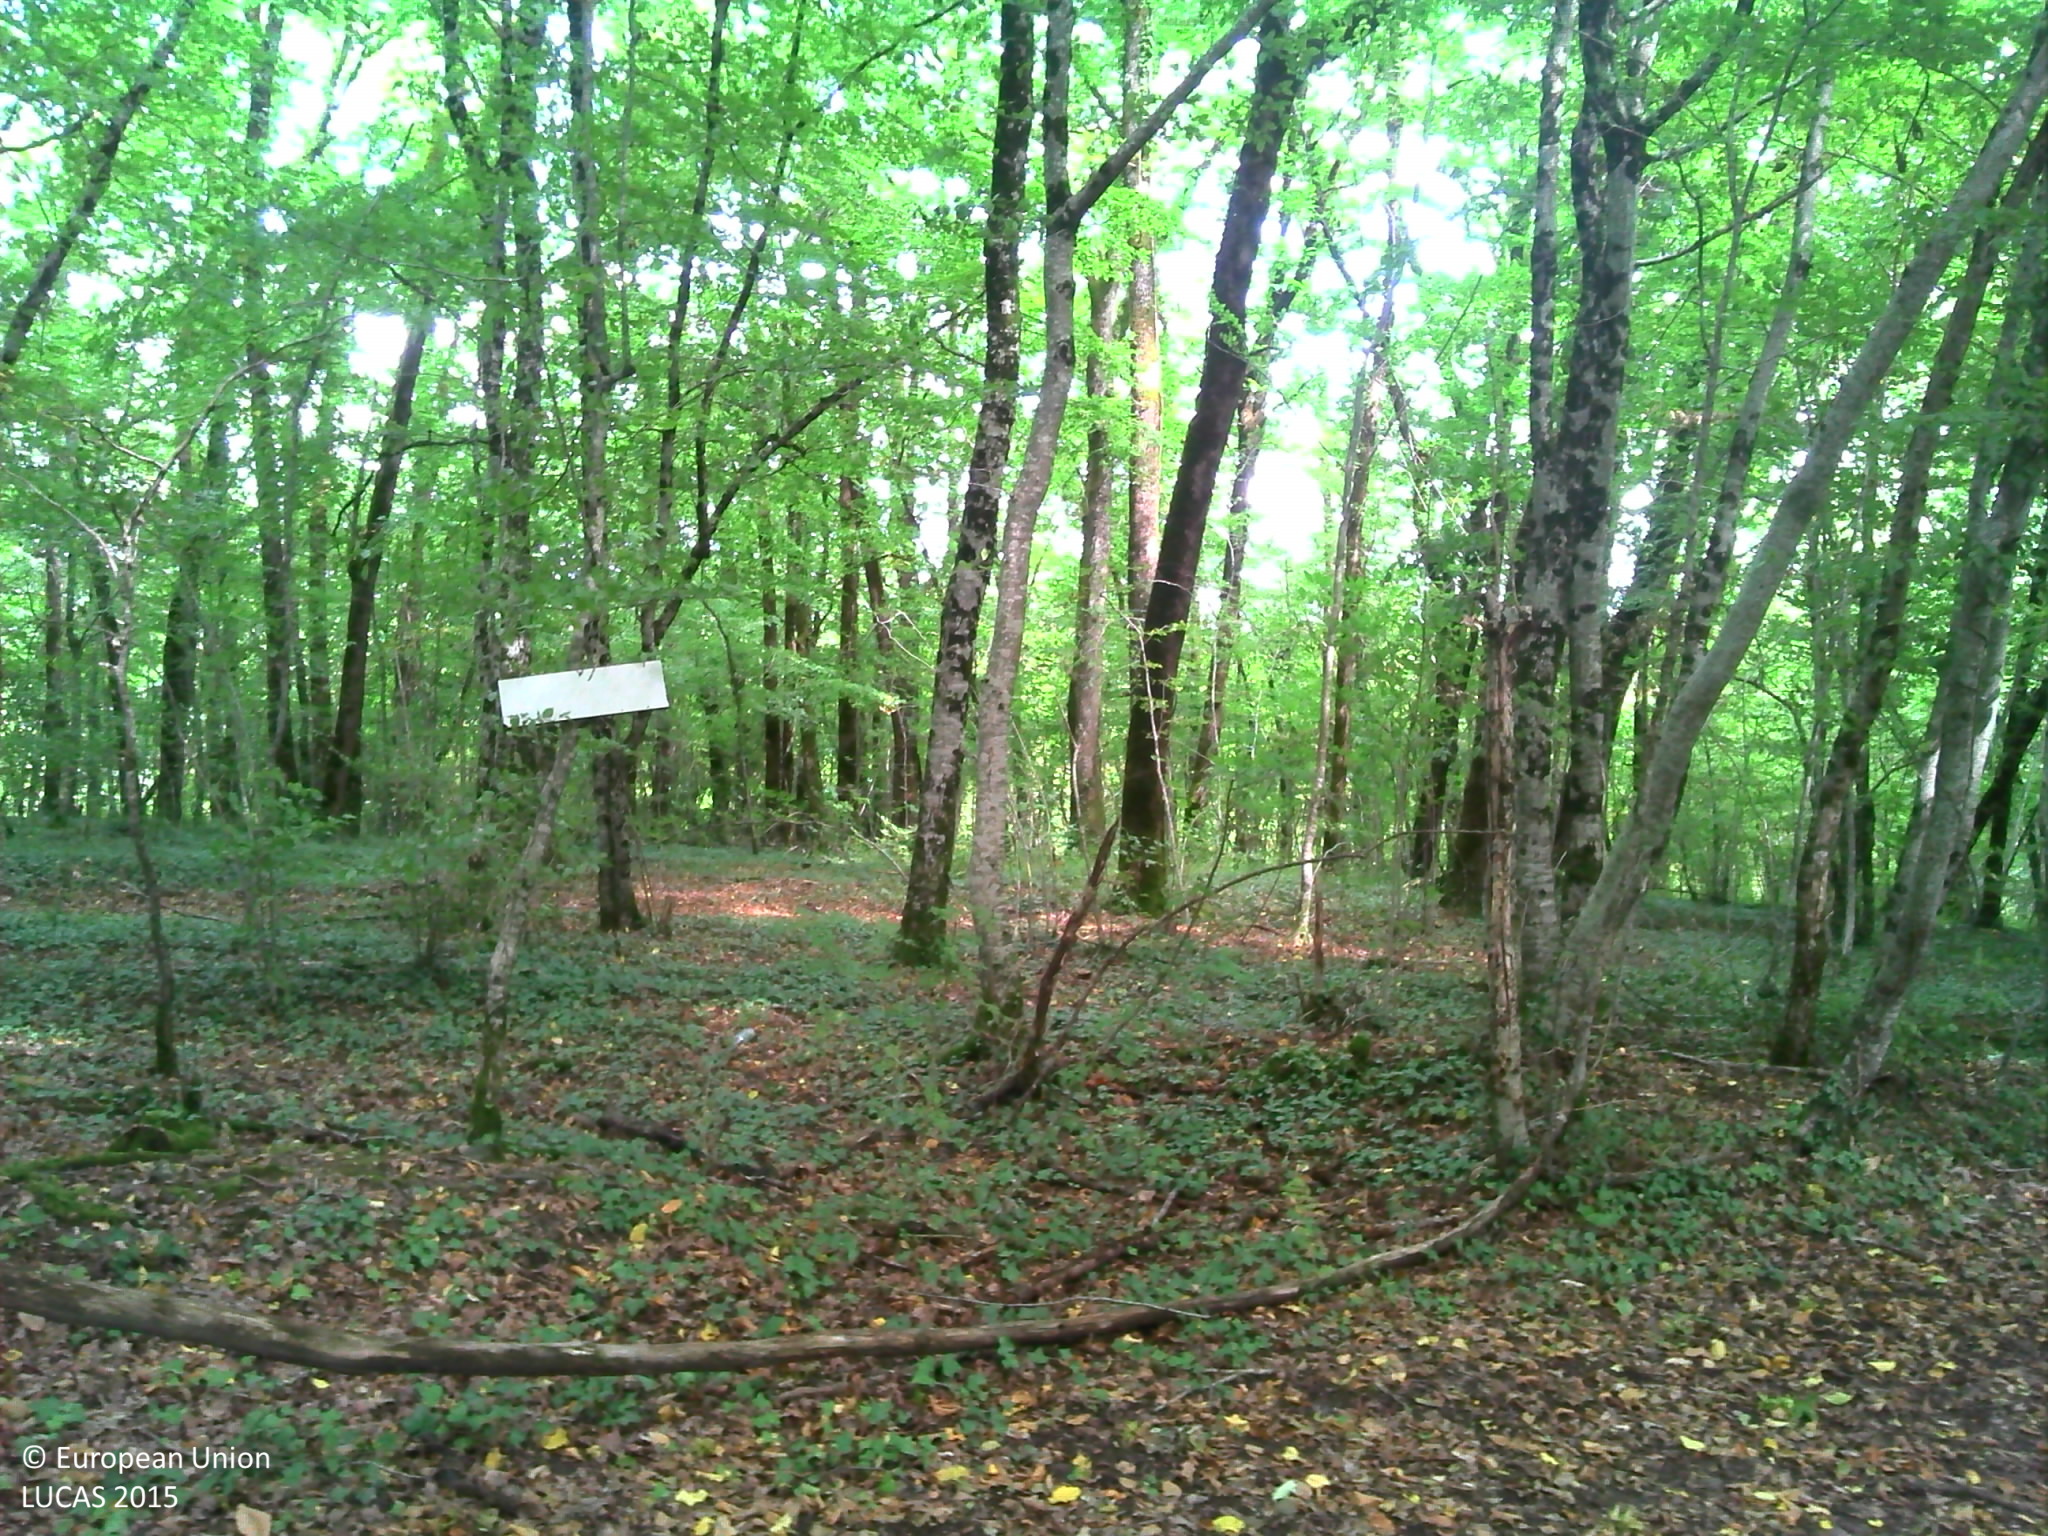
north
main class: Woodland
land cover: Broadleaved woodland
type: mesophytic deciduous forest
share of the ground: > 75 %
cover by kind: broadleaved forest trees 85 %, unconsolidated bare surface 10 %, herbaceous plants 5 %
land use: Forestry
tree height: > 5 m
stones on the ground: < 10 %
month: August
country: FR
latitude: 45.3077
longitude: 0.6658
